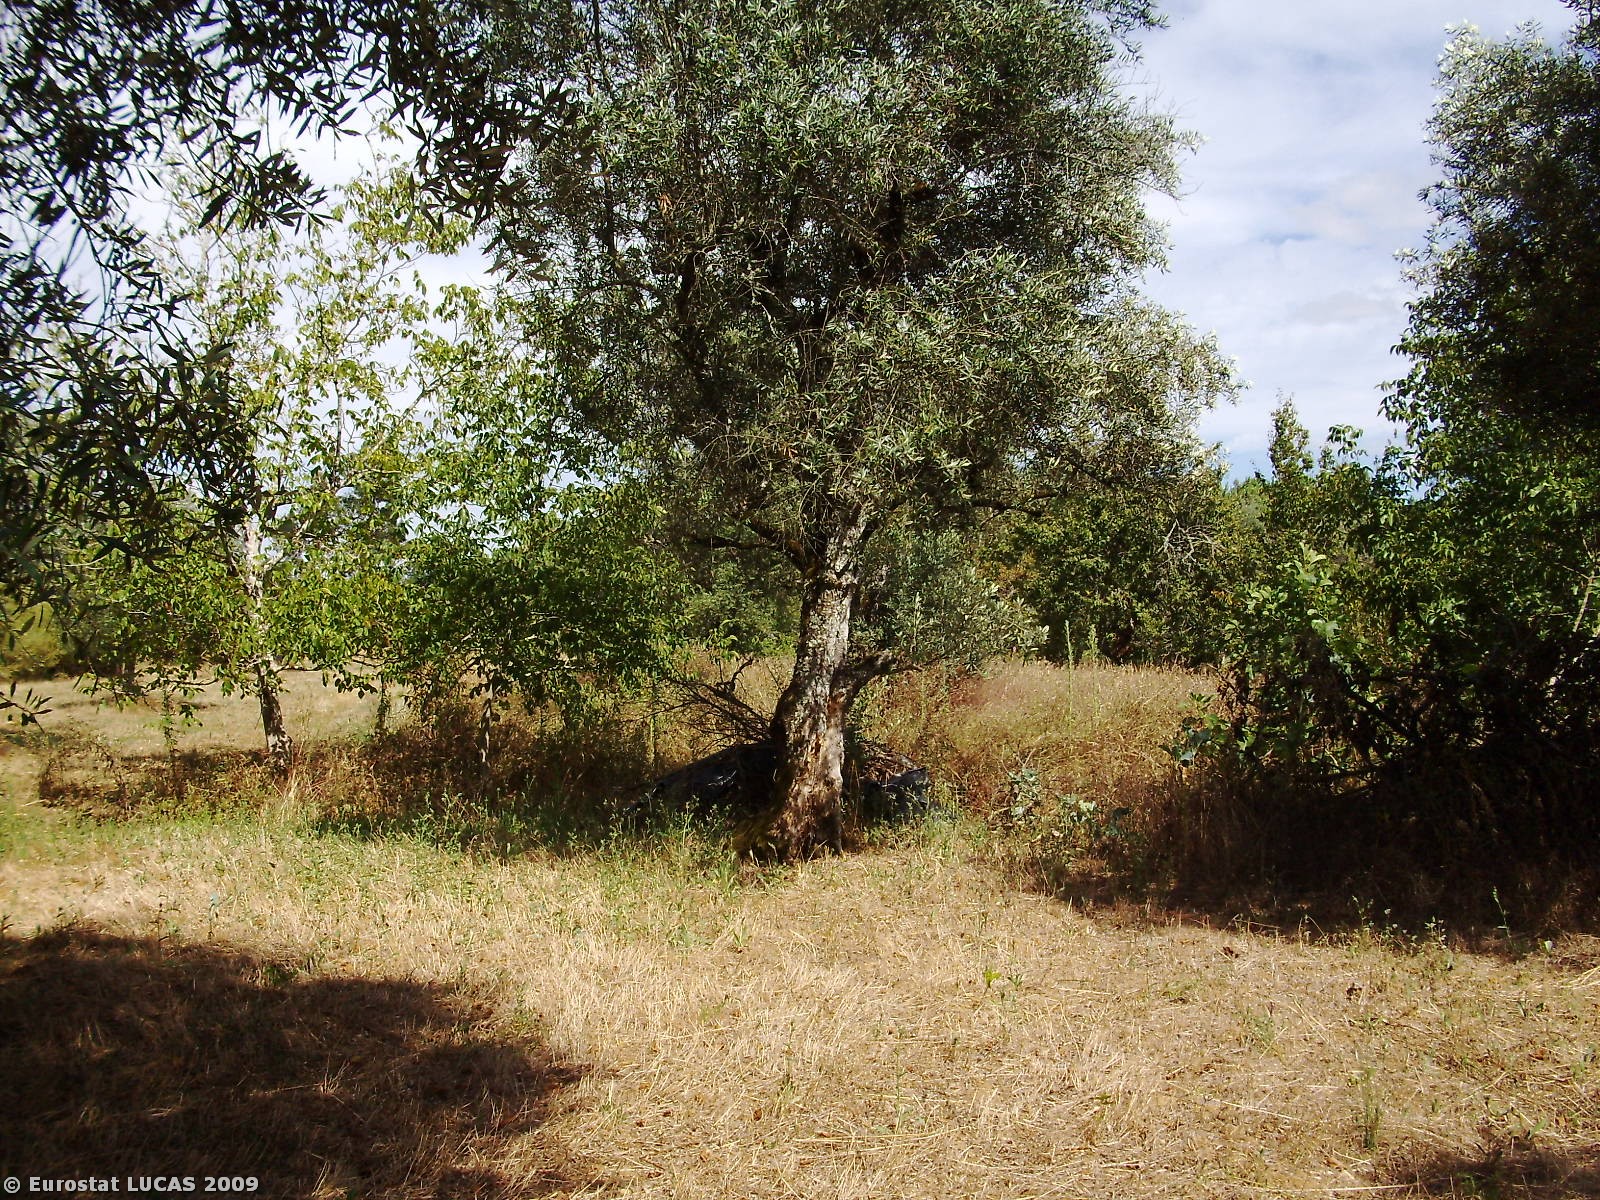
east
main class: Cropland
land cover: Olive groves
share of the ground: 25 - 50 %
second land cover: Spontaneously vegetated surfaces
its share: 10 - 25 %
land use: Agriculture (excluding fallow land and kitchen gardens)
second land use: Fallow land
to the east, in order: Olive groves; Spontaneously vegetated surfaces; Olive groves; Ditches and canals; Olive groves; Spontaneously vegetated surfaces; Vineyards; Spontaneously vegetated surfaces; Olive groves; Spontaneously vegetated surfaces; Tracks; Maize; Apple fruit; Coniferous woodland; Shrubland with sparse tree cover; Tracks; Coniferous woodland
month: August
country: PT
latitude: 40.1284
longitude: -8.5450
